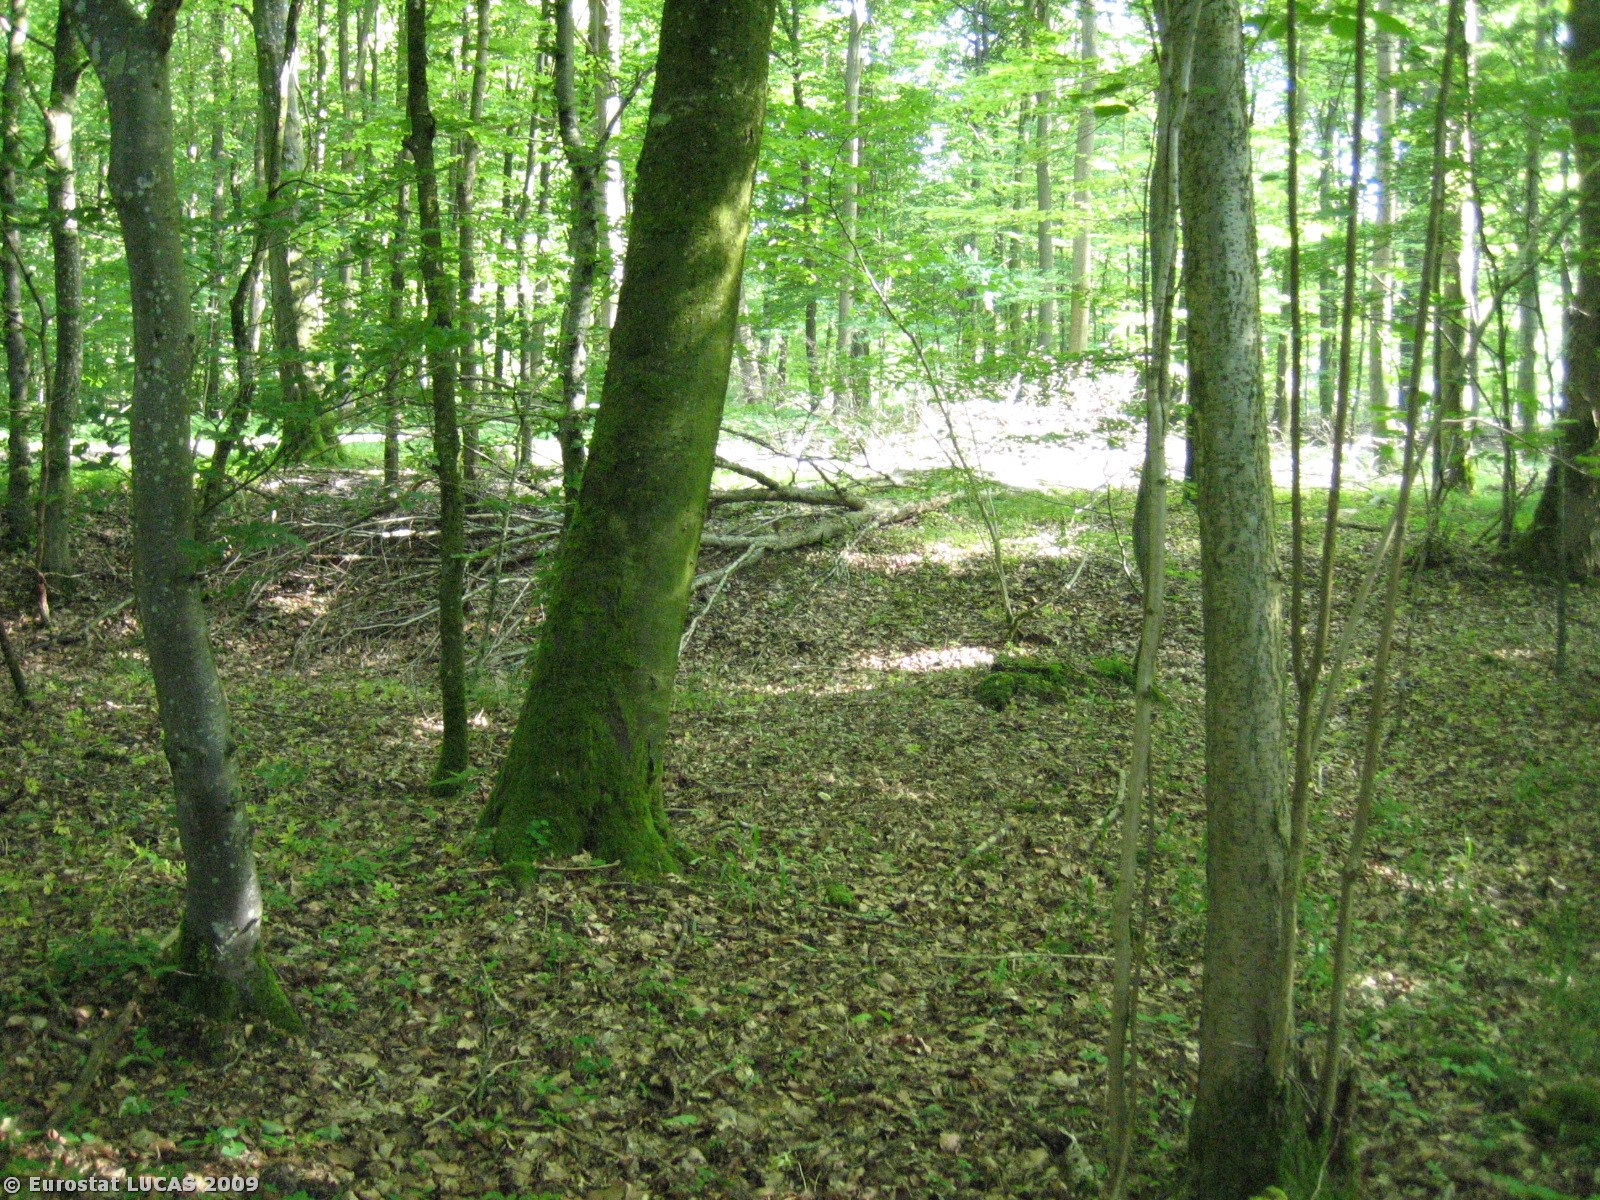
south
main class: Woodland
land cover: Broadleaved woodland
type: mesophytic deciduous forest
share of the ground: > 75 %
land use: Forestry
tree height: > 5 m
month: June
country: DK
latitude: 55.8101
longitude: 9.7928
